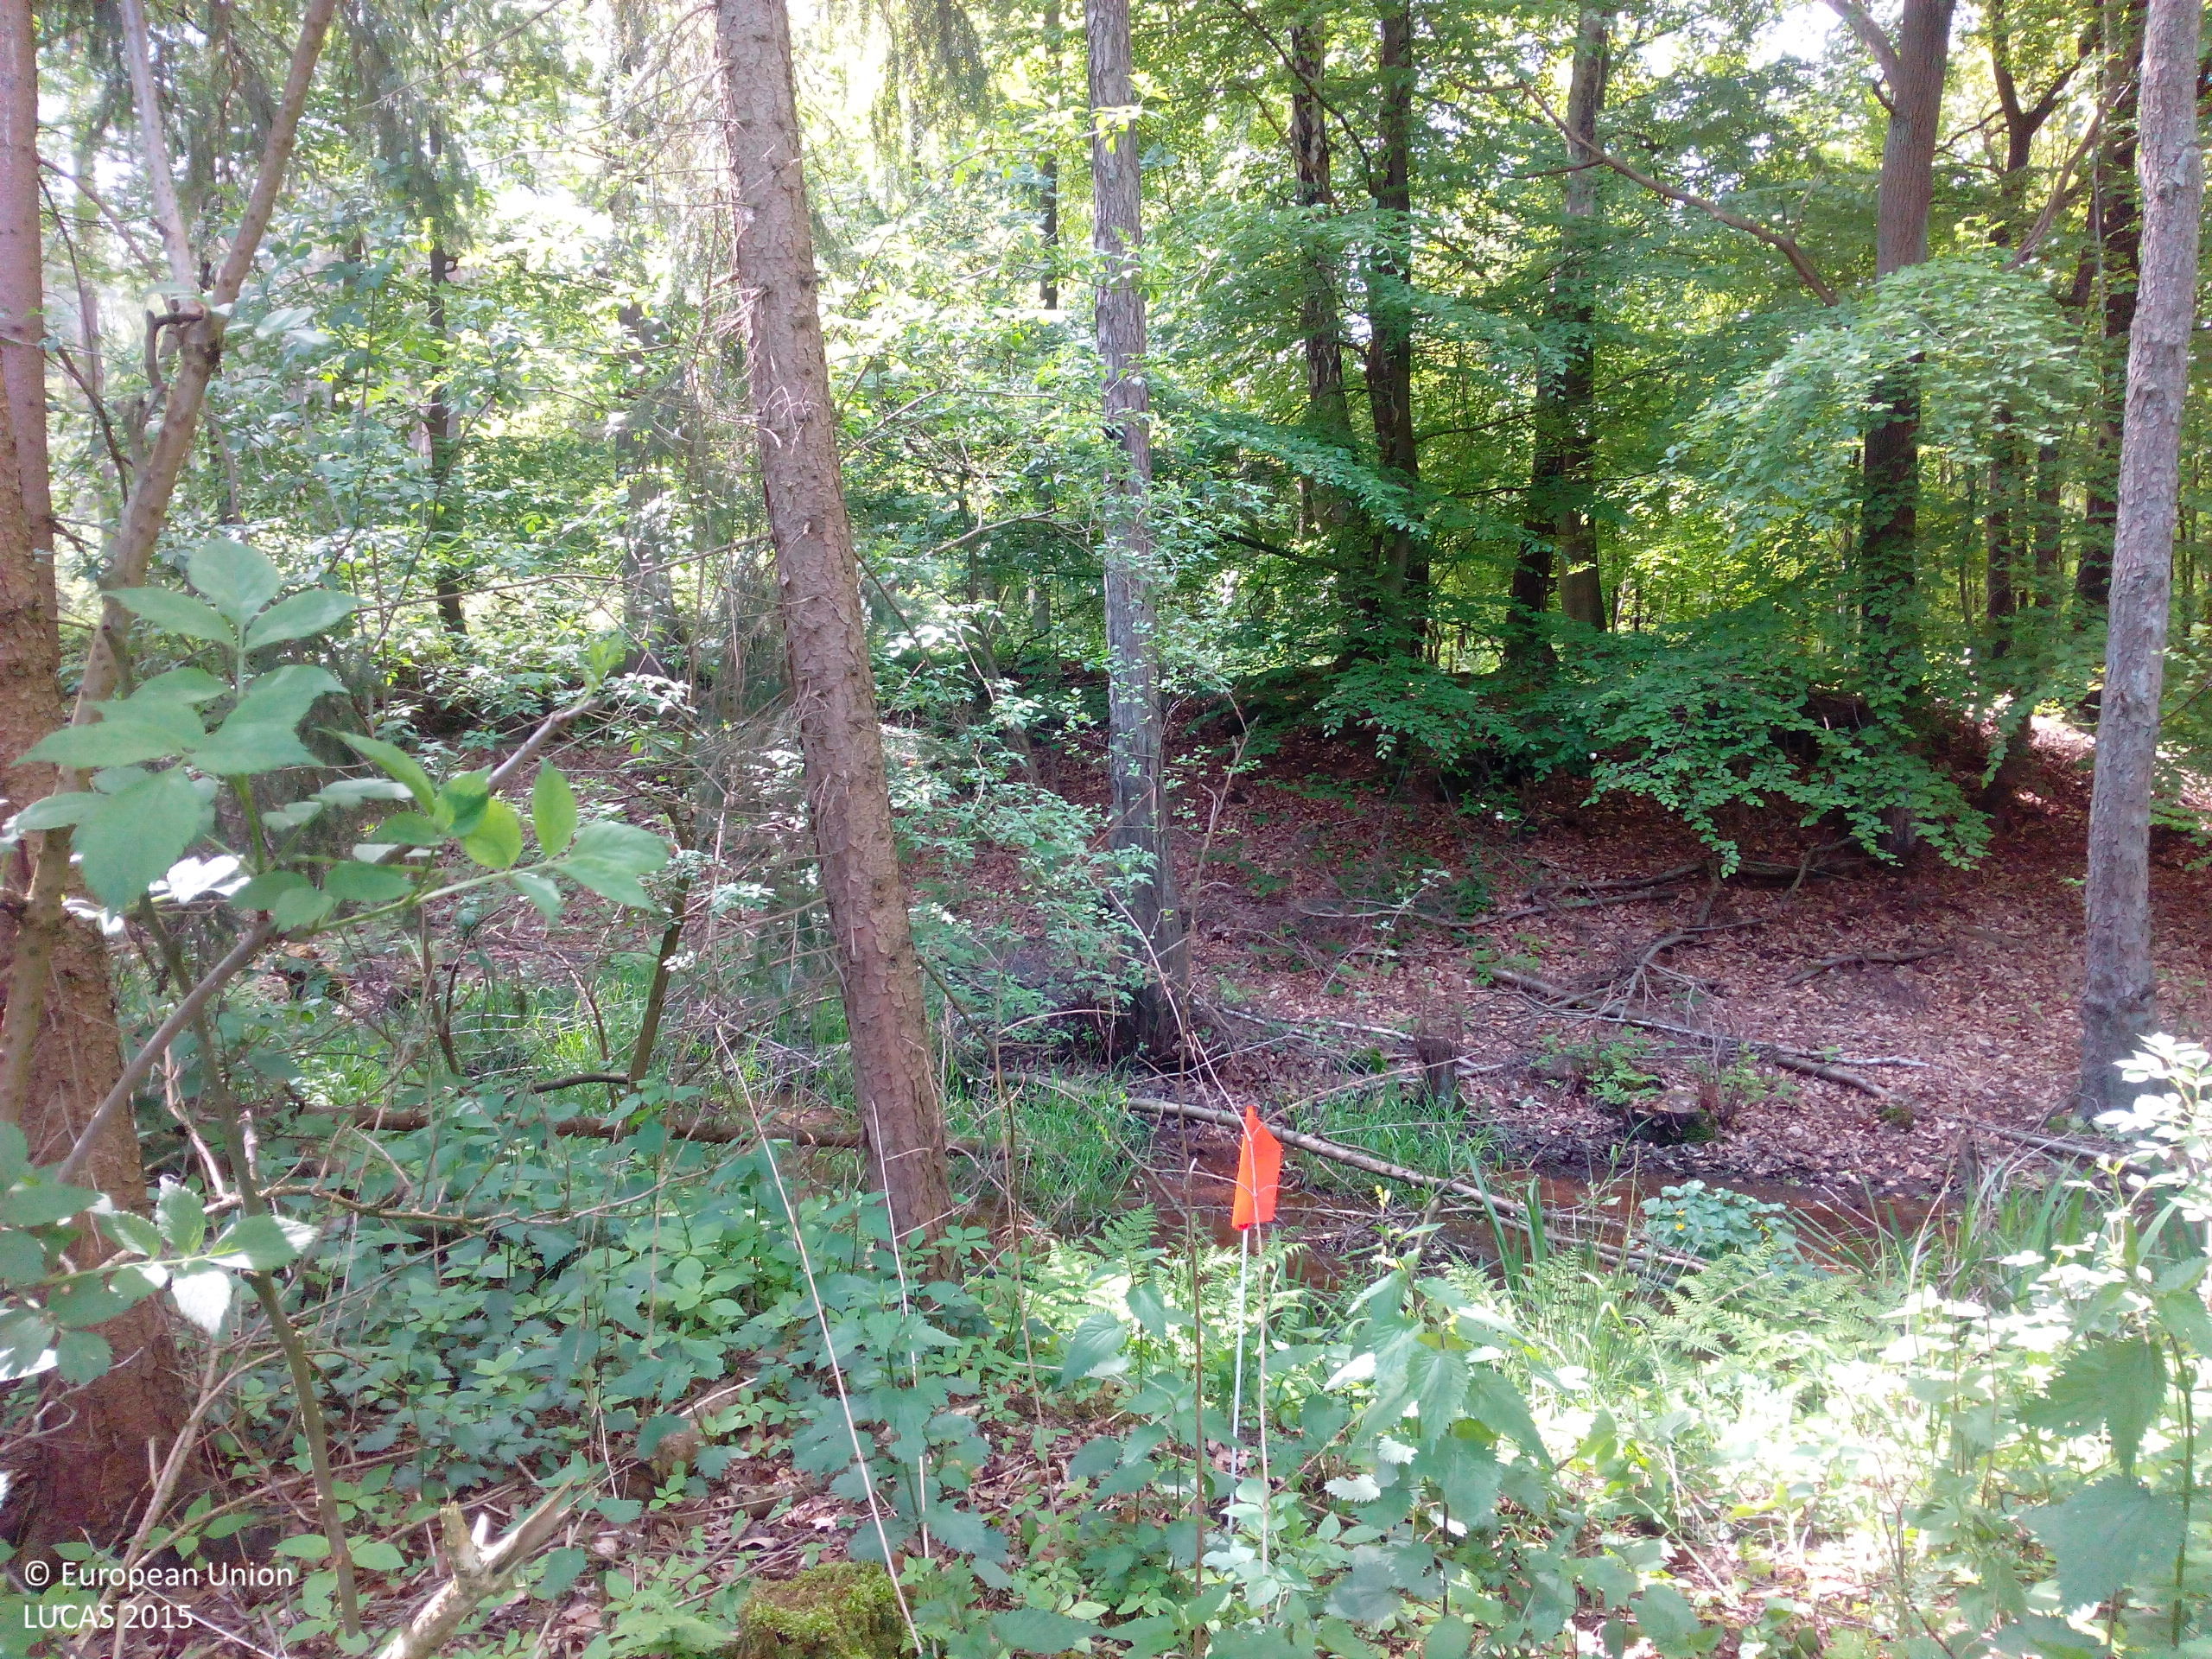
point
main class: Woodland
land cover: Other mixed woodland
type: mire and swamp forests
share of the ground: > 75 %
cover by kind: coniferous forest trees 45 %, broadleaved forest trees 40 %, herbaceous plants 10 %, shrubs 5 %
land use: Forestry
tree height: > 5 m
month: May
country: DE
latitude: 52.2240
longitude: 7.4385
